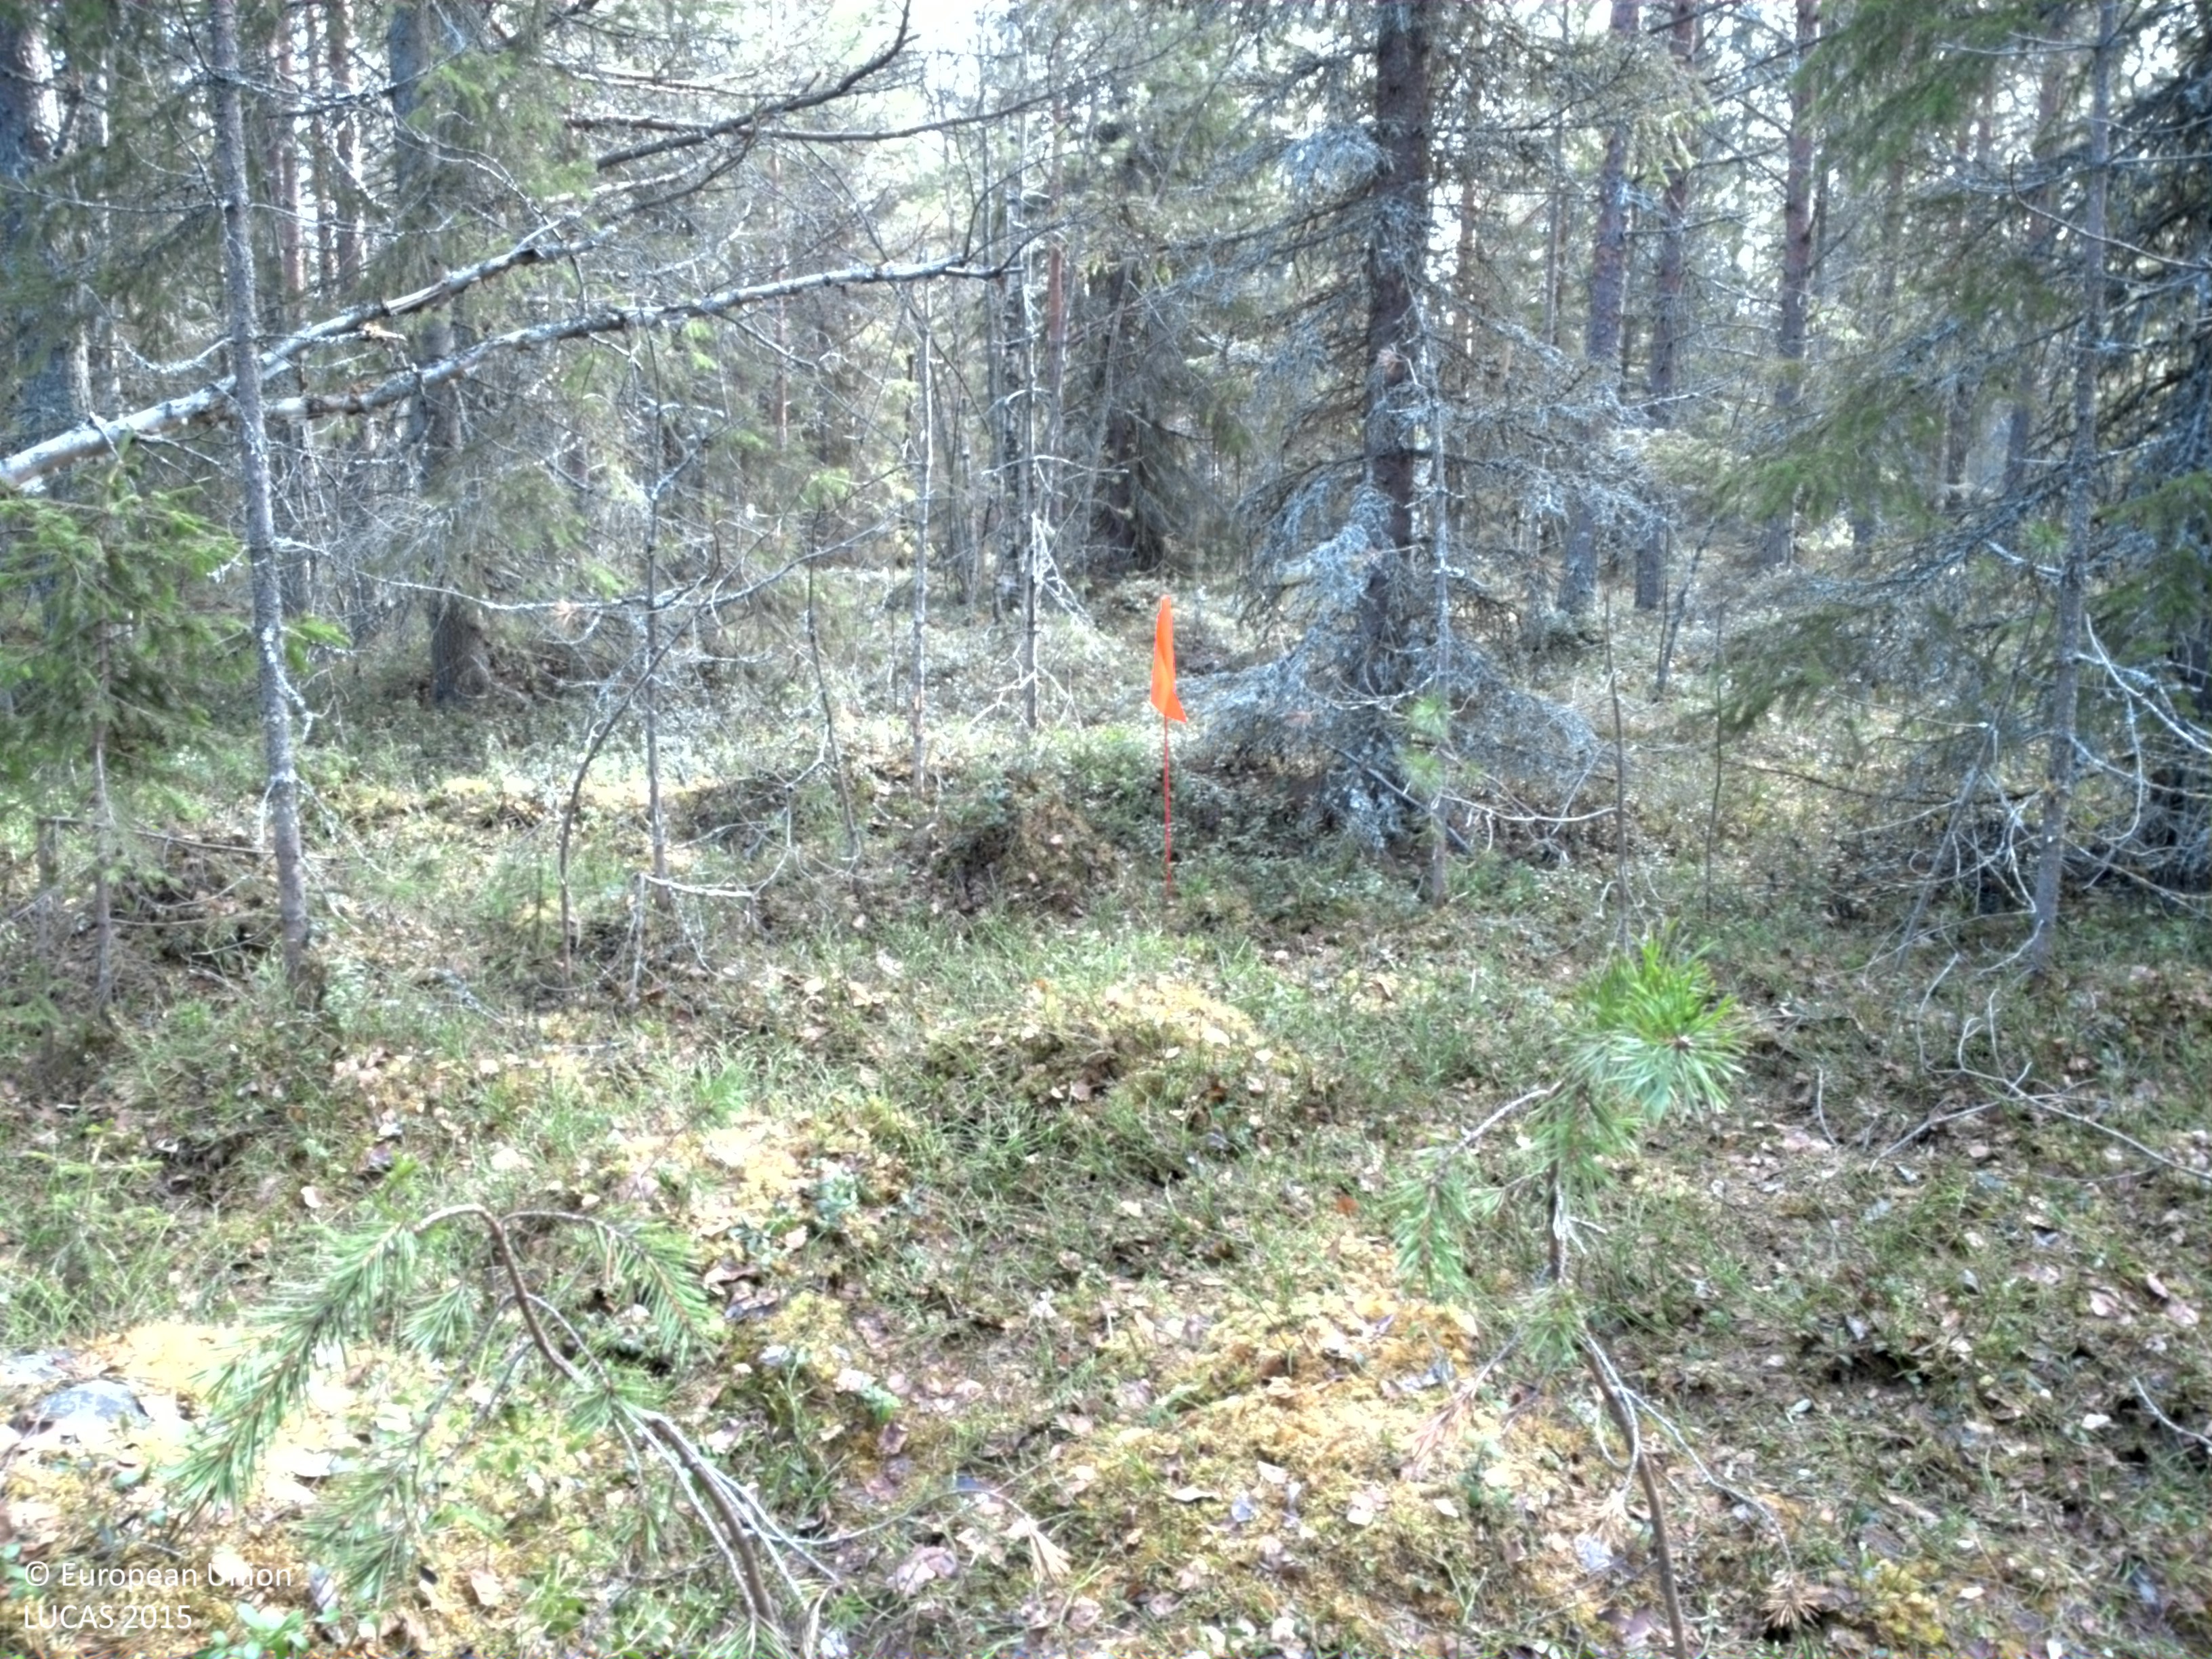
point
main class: Woodland
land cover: Pine dominated coniferous woodland
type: boreal forest
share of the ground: > 75 %
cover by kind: coniferous forest trees 80 %, shrubs 10 %, broadleaved forest trees 5 %, lichens and mosses 5 %
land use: Forestry
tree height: > 5 m
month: May
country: SE
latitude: 65.7416
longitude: 23.1426
